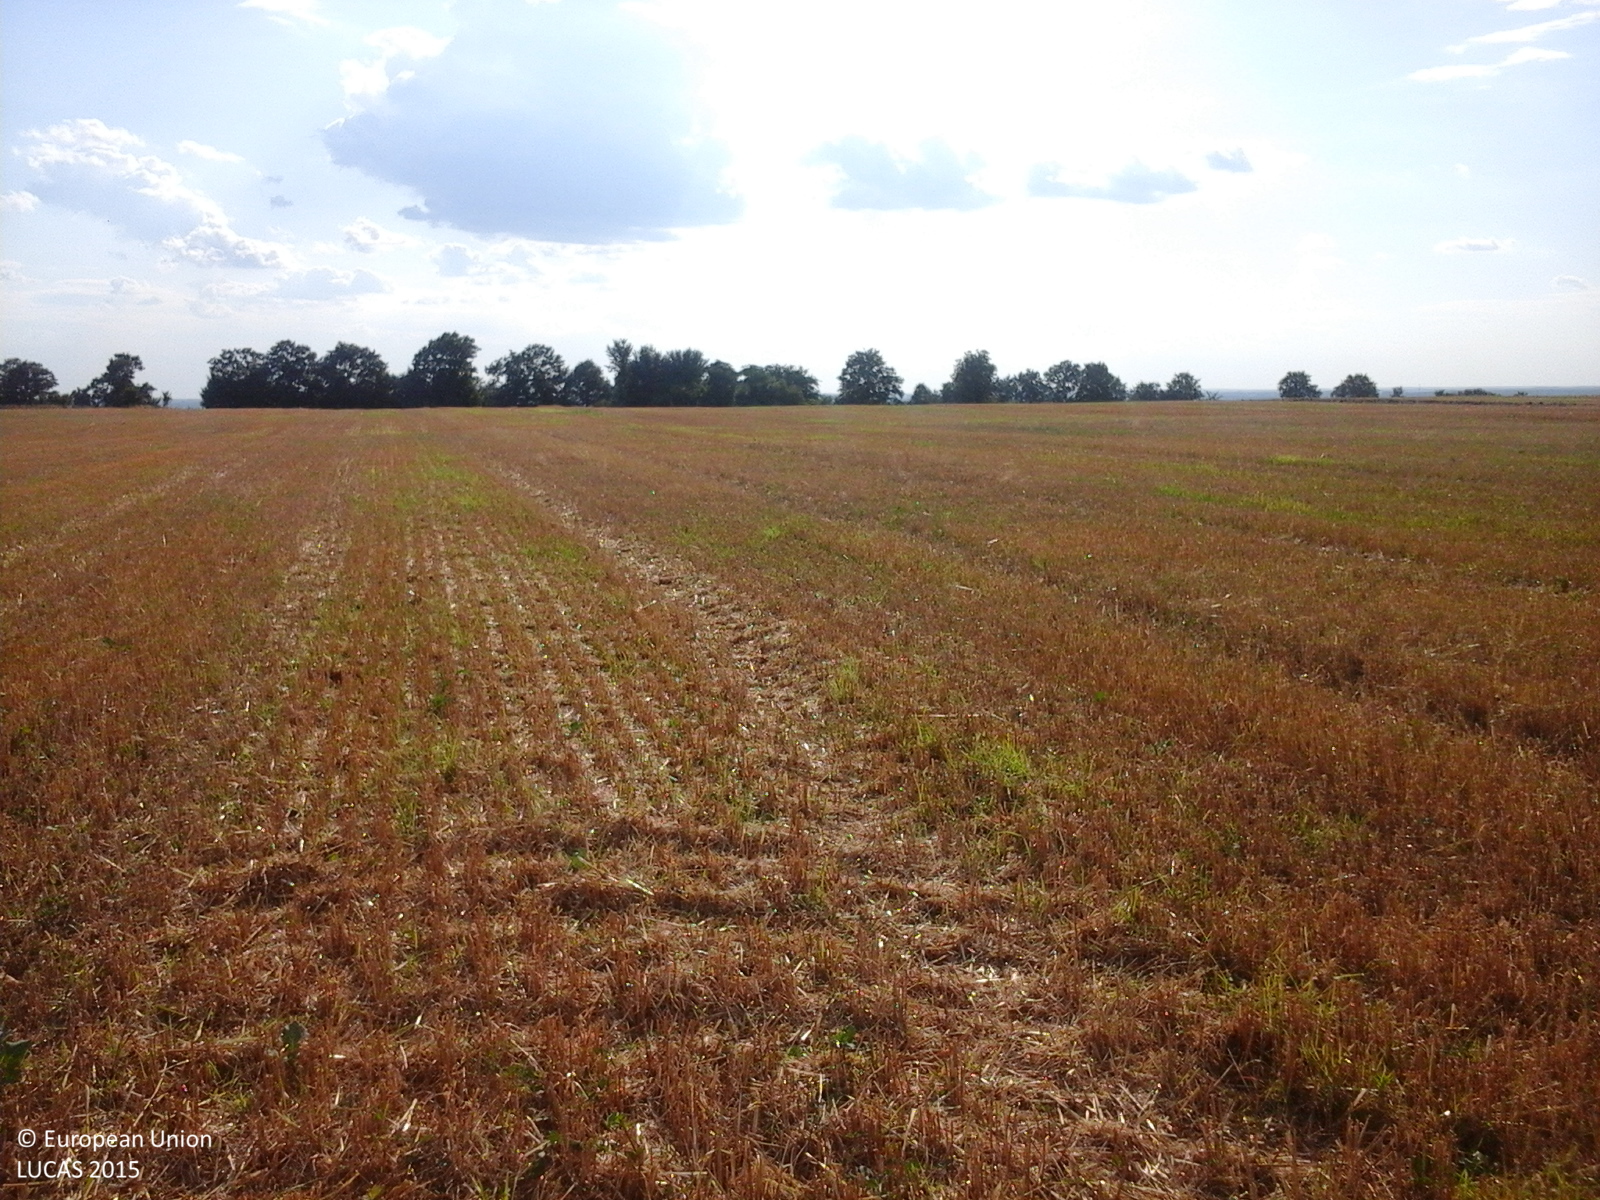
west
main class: Cropland
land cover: Barley
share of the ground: < 10 %
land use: Agriculture (excluding fallow land and kitchen gardens)
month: July
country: RO
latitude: 44.0954
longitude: 24.6216
